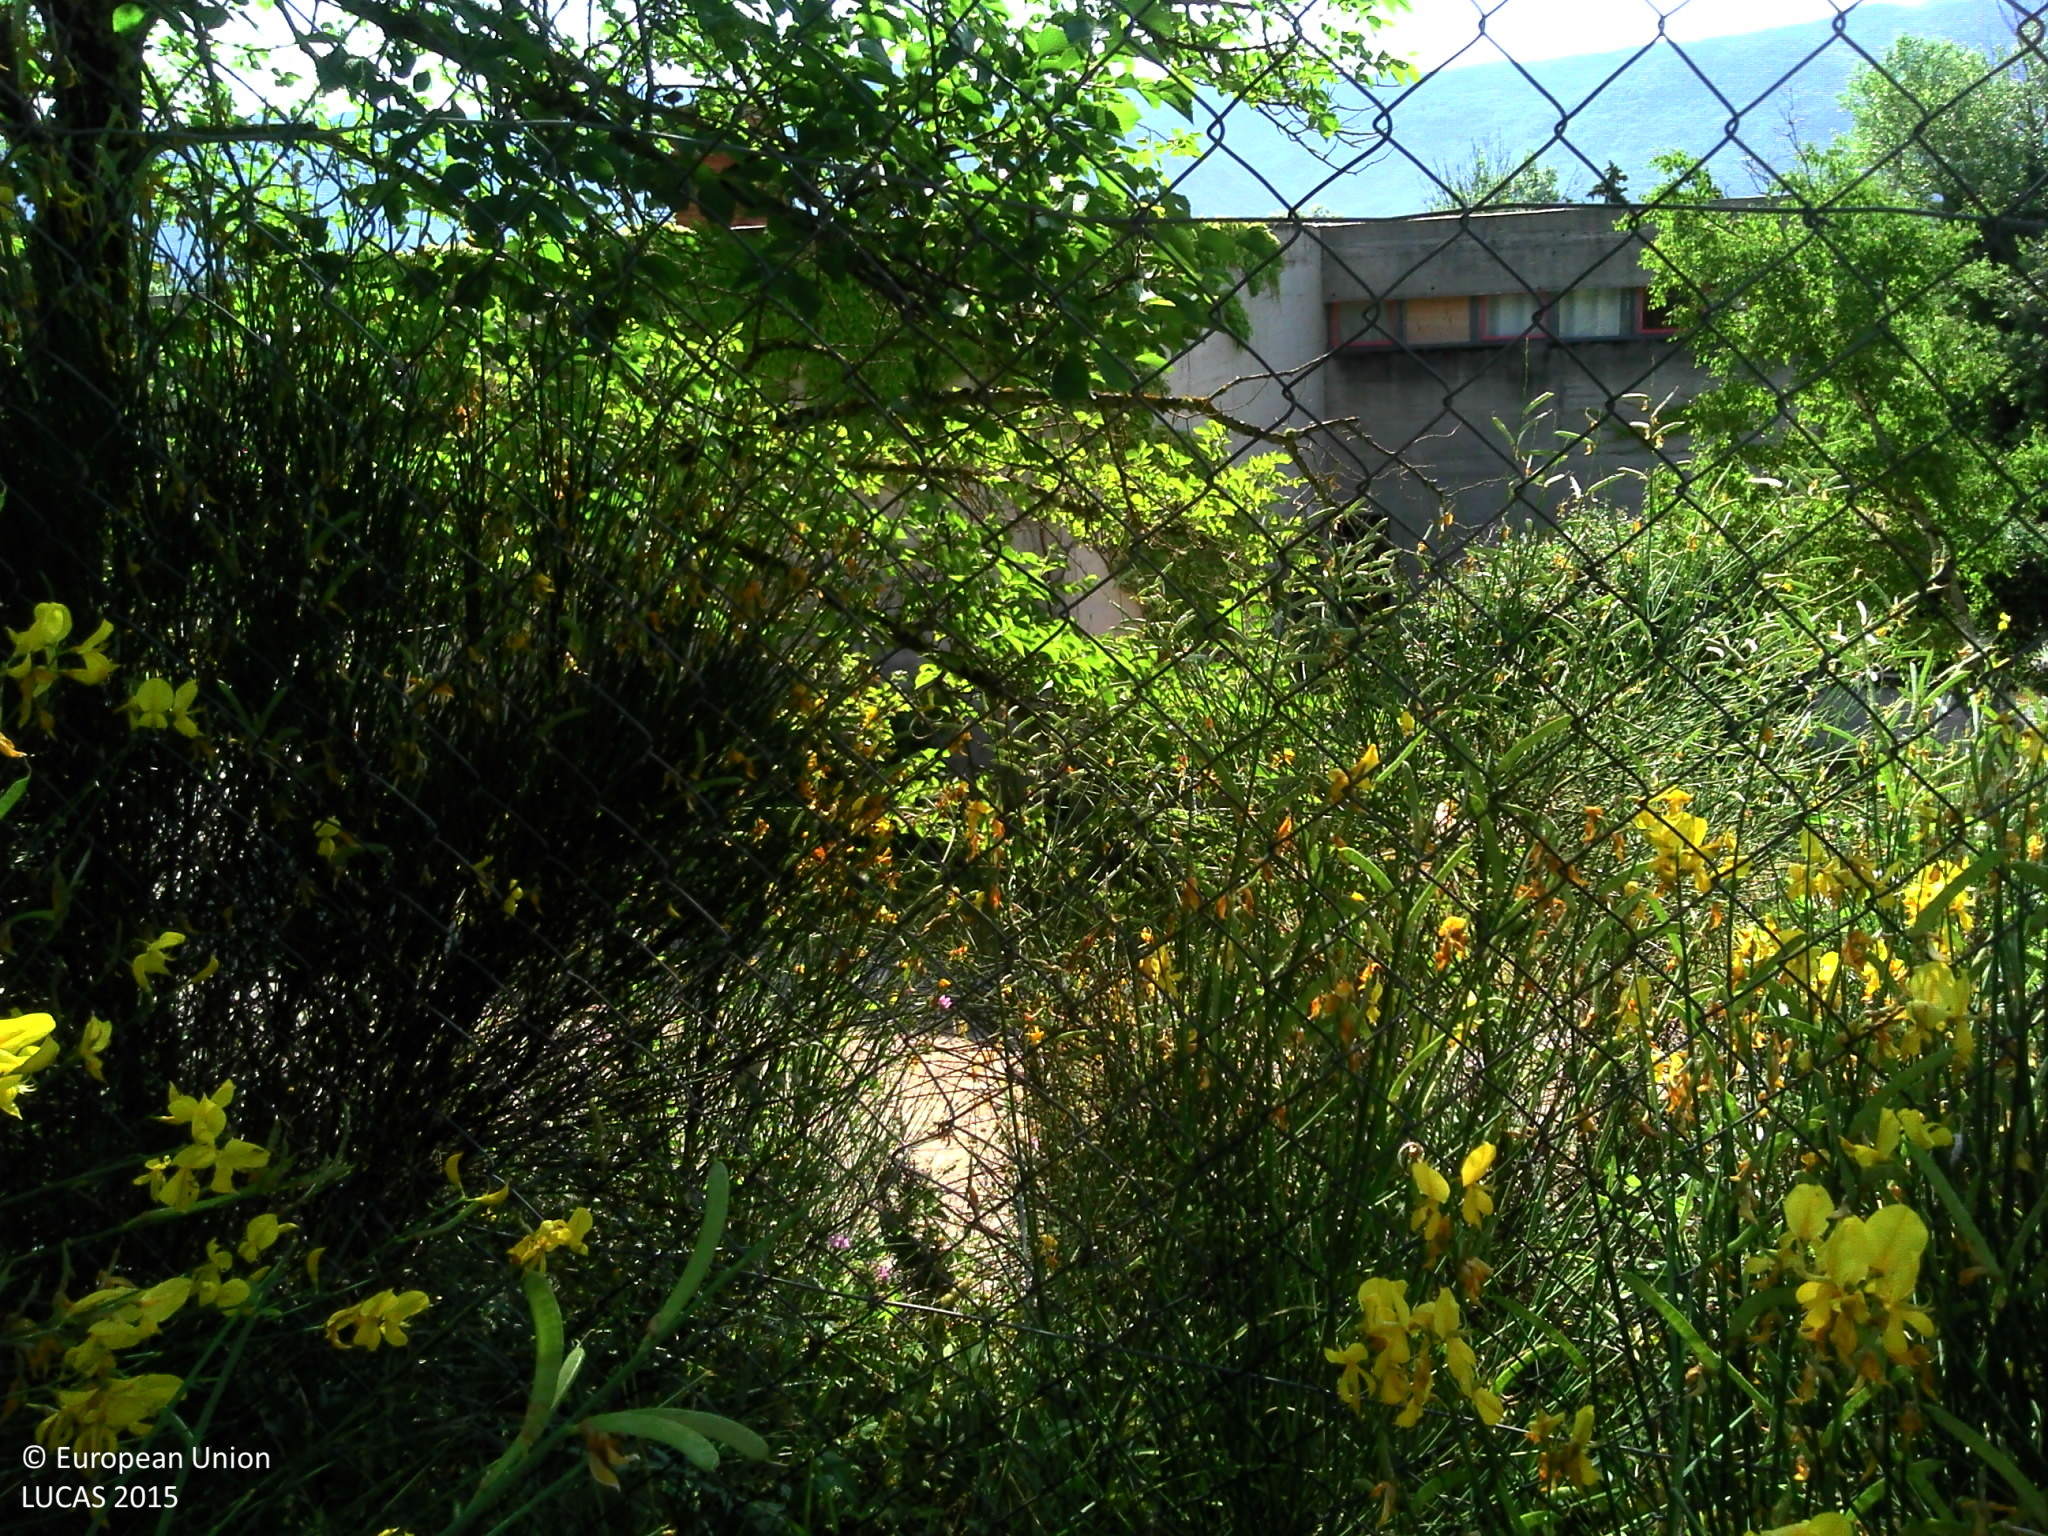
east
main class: Shrubland
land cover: Shrubland with sparse tree cover
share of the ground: > 75 %
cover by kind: herbaceous plants 85 %, shrubs 10 %, broadleaved forest trees 5 %
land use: Residential
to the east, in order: Shrubland with sparse tree cover; Fences; Shrubland with sparse tree cover; Artificial constructions in urban areas
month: June
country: FR
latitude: 44.7113
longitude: 5.2477
